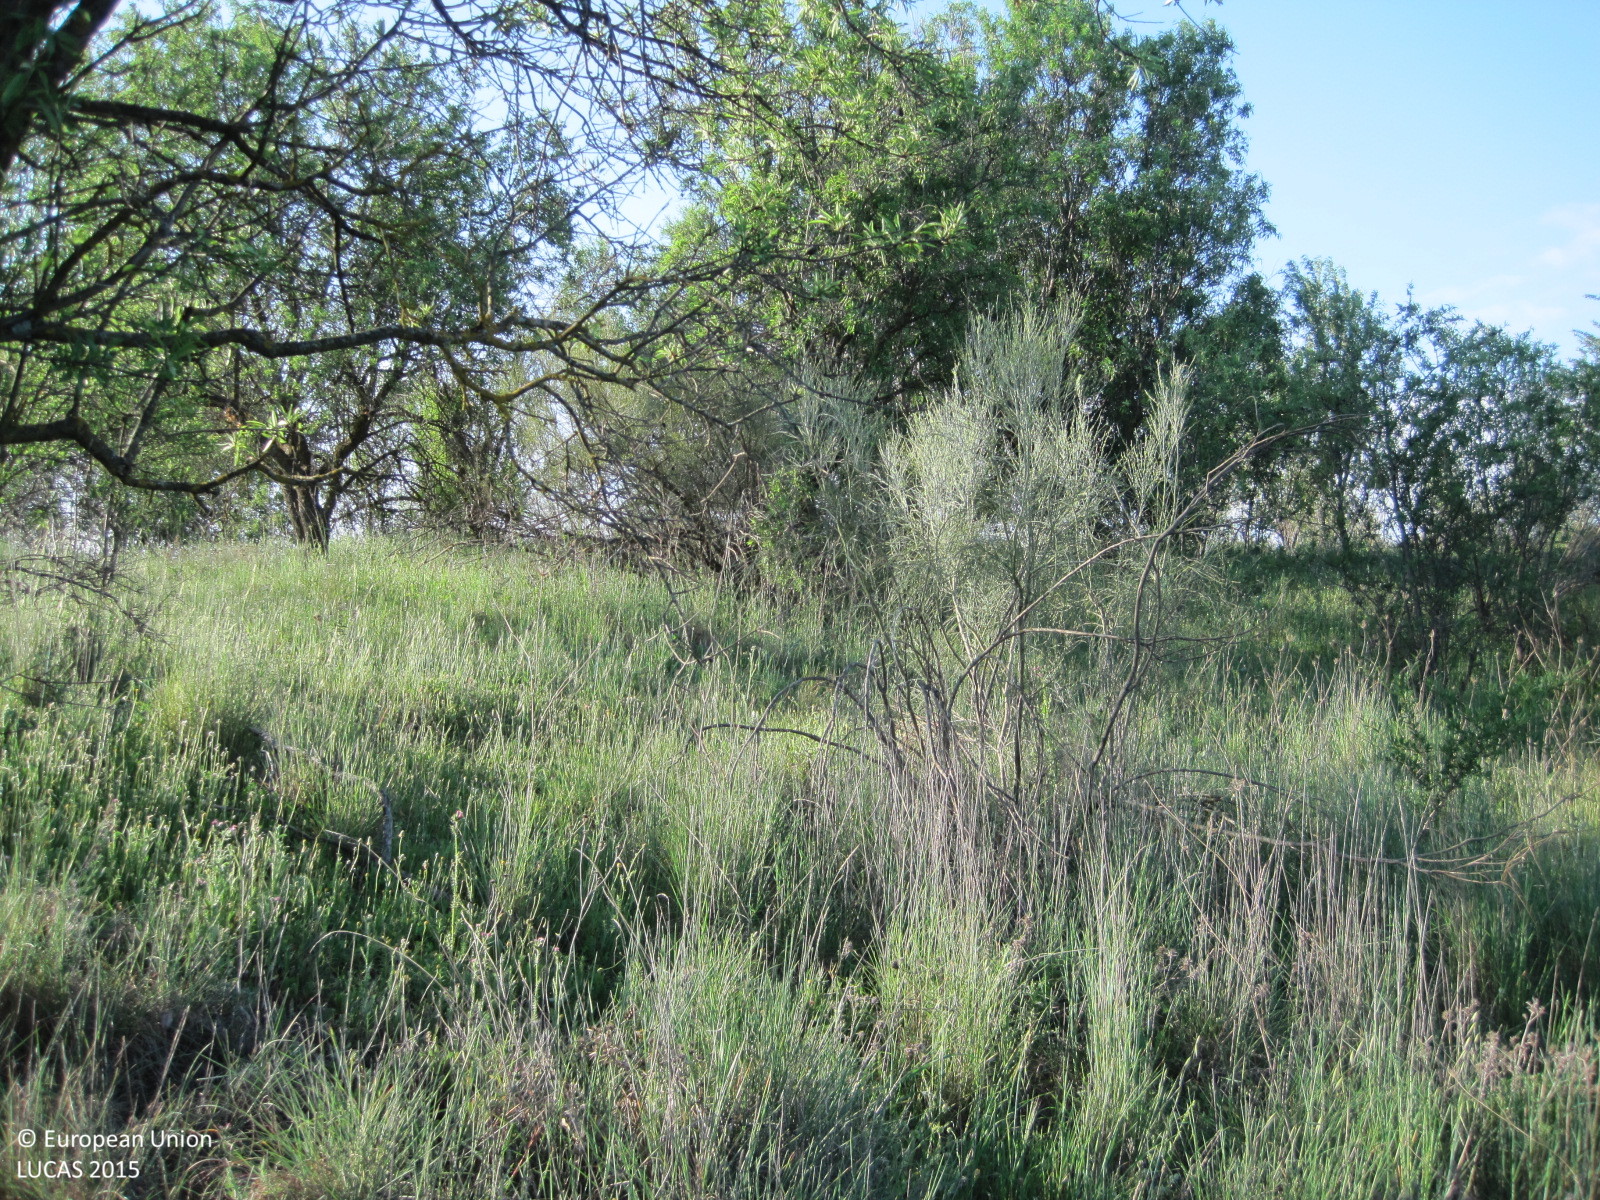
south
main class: Woodland
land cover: Broadleaved woodland
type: thermophilous deciduous forest
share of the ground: 10 - 25 %
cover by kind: herbaceous plants 50 %, shrubs 35 %, broadleaved forest trees 15 %
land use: Agriculture (excluding fallow land and kitchen gardens)
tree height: < 5 m
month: April
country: ES
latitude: 39.8563
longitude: -4.9039
